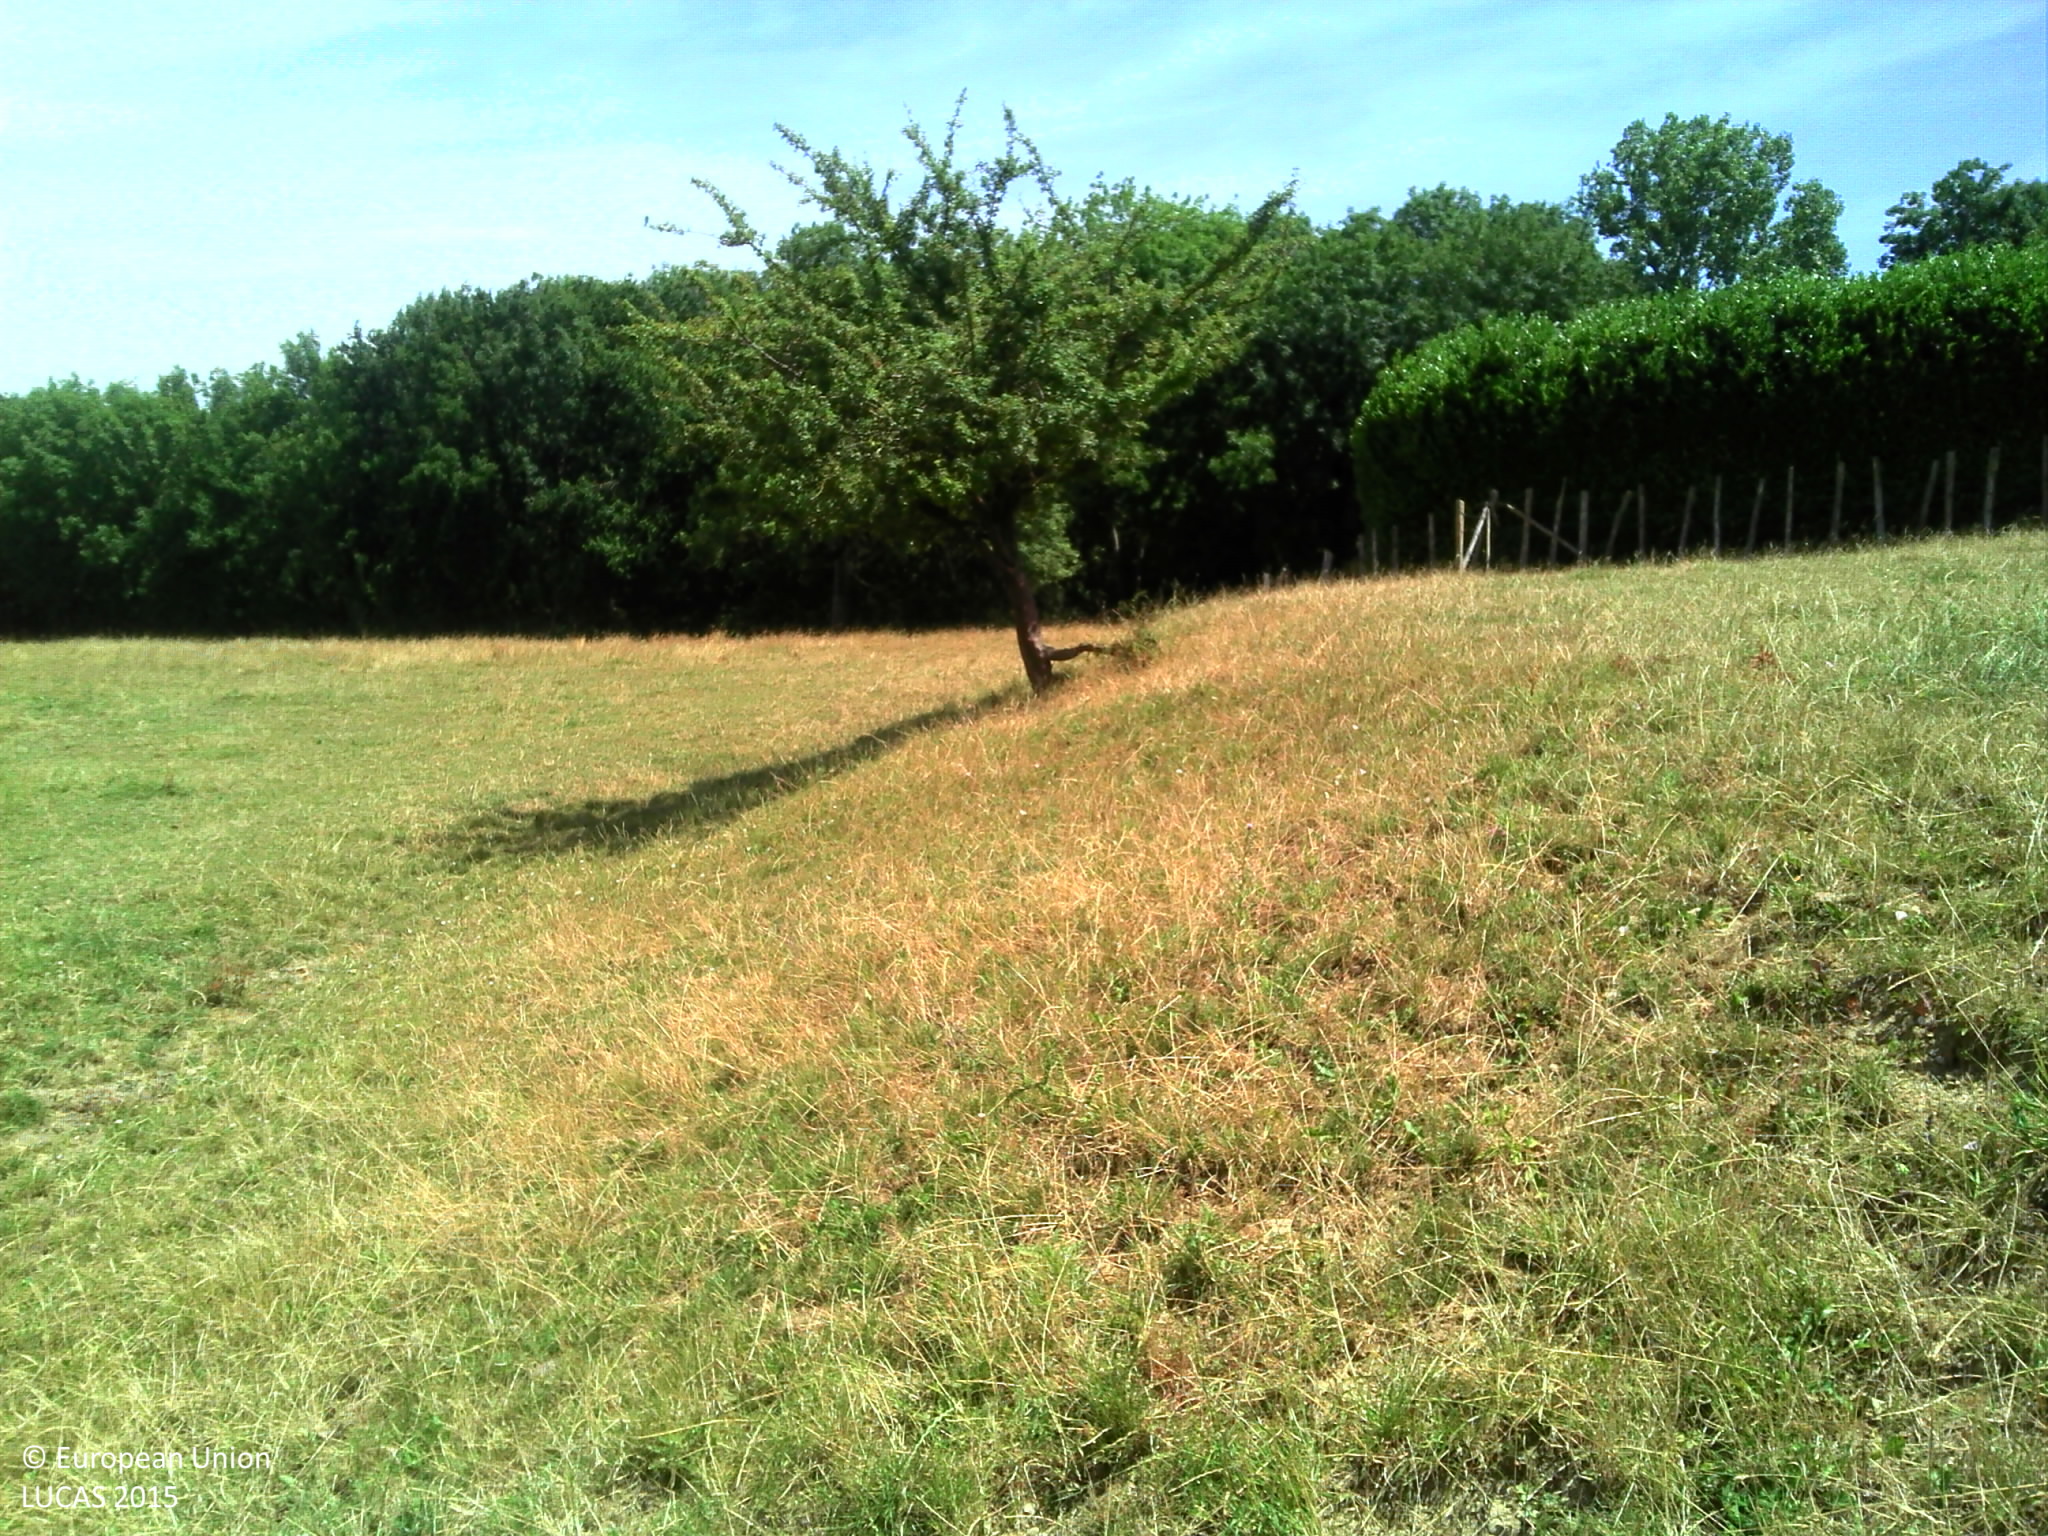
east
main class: Grassland
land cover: Grassland with sparse tree/shrub cover
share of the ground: > 75 %
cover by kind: herbaceous plants 90 %, broadleaved forest trees 5 %, consolidated bare surface 5 %
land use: Agriculture (excluding fallow land and kitchen gardens)
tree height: > 5 m
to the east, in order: Grassland with sparse tree/shrub cover; Single bushes/trees; Grassland with sparse tree/shrub cover; Fences; Managed hedges; Grassland without tree/shrub cover; Paved roads, cycling and walking lanes; Broadleaved woodland; Artificial constructions in urban areas; Rape and turnip rape
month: July
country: FR
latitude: 45.3049
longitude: 5.1968
